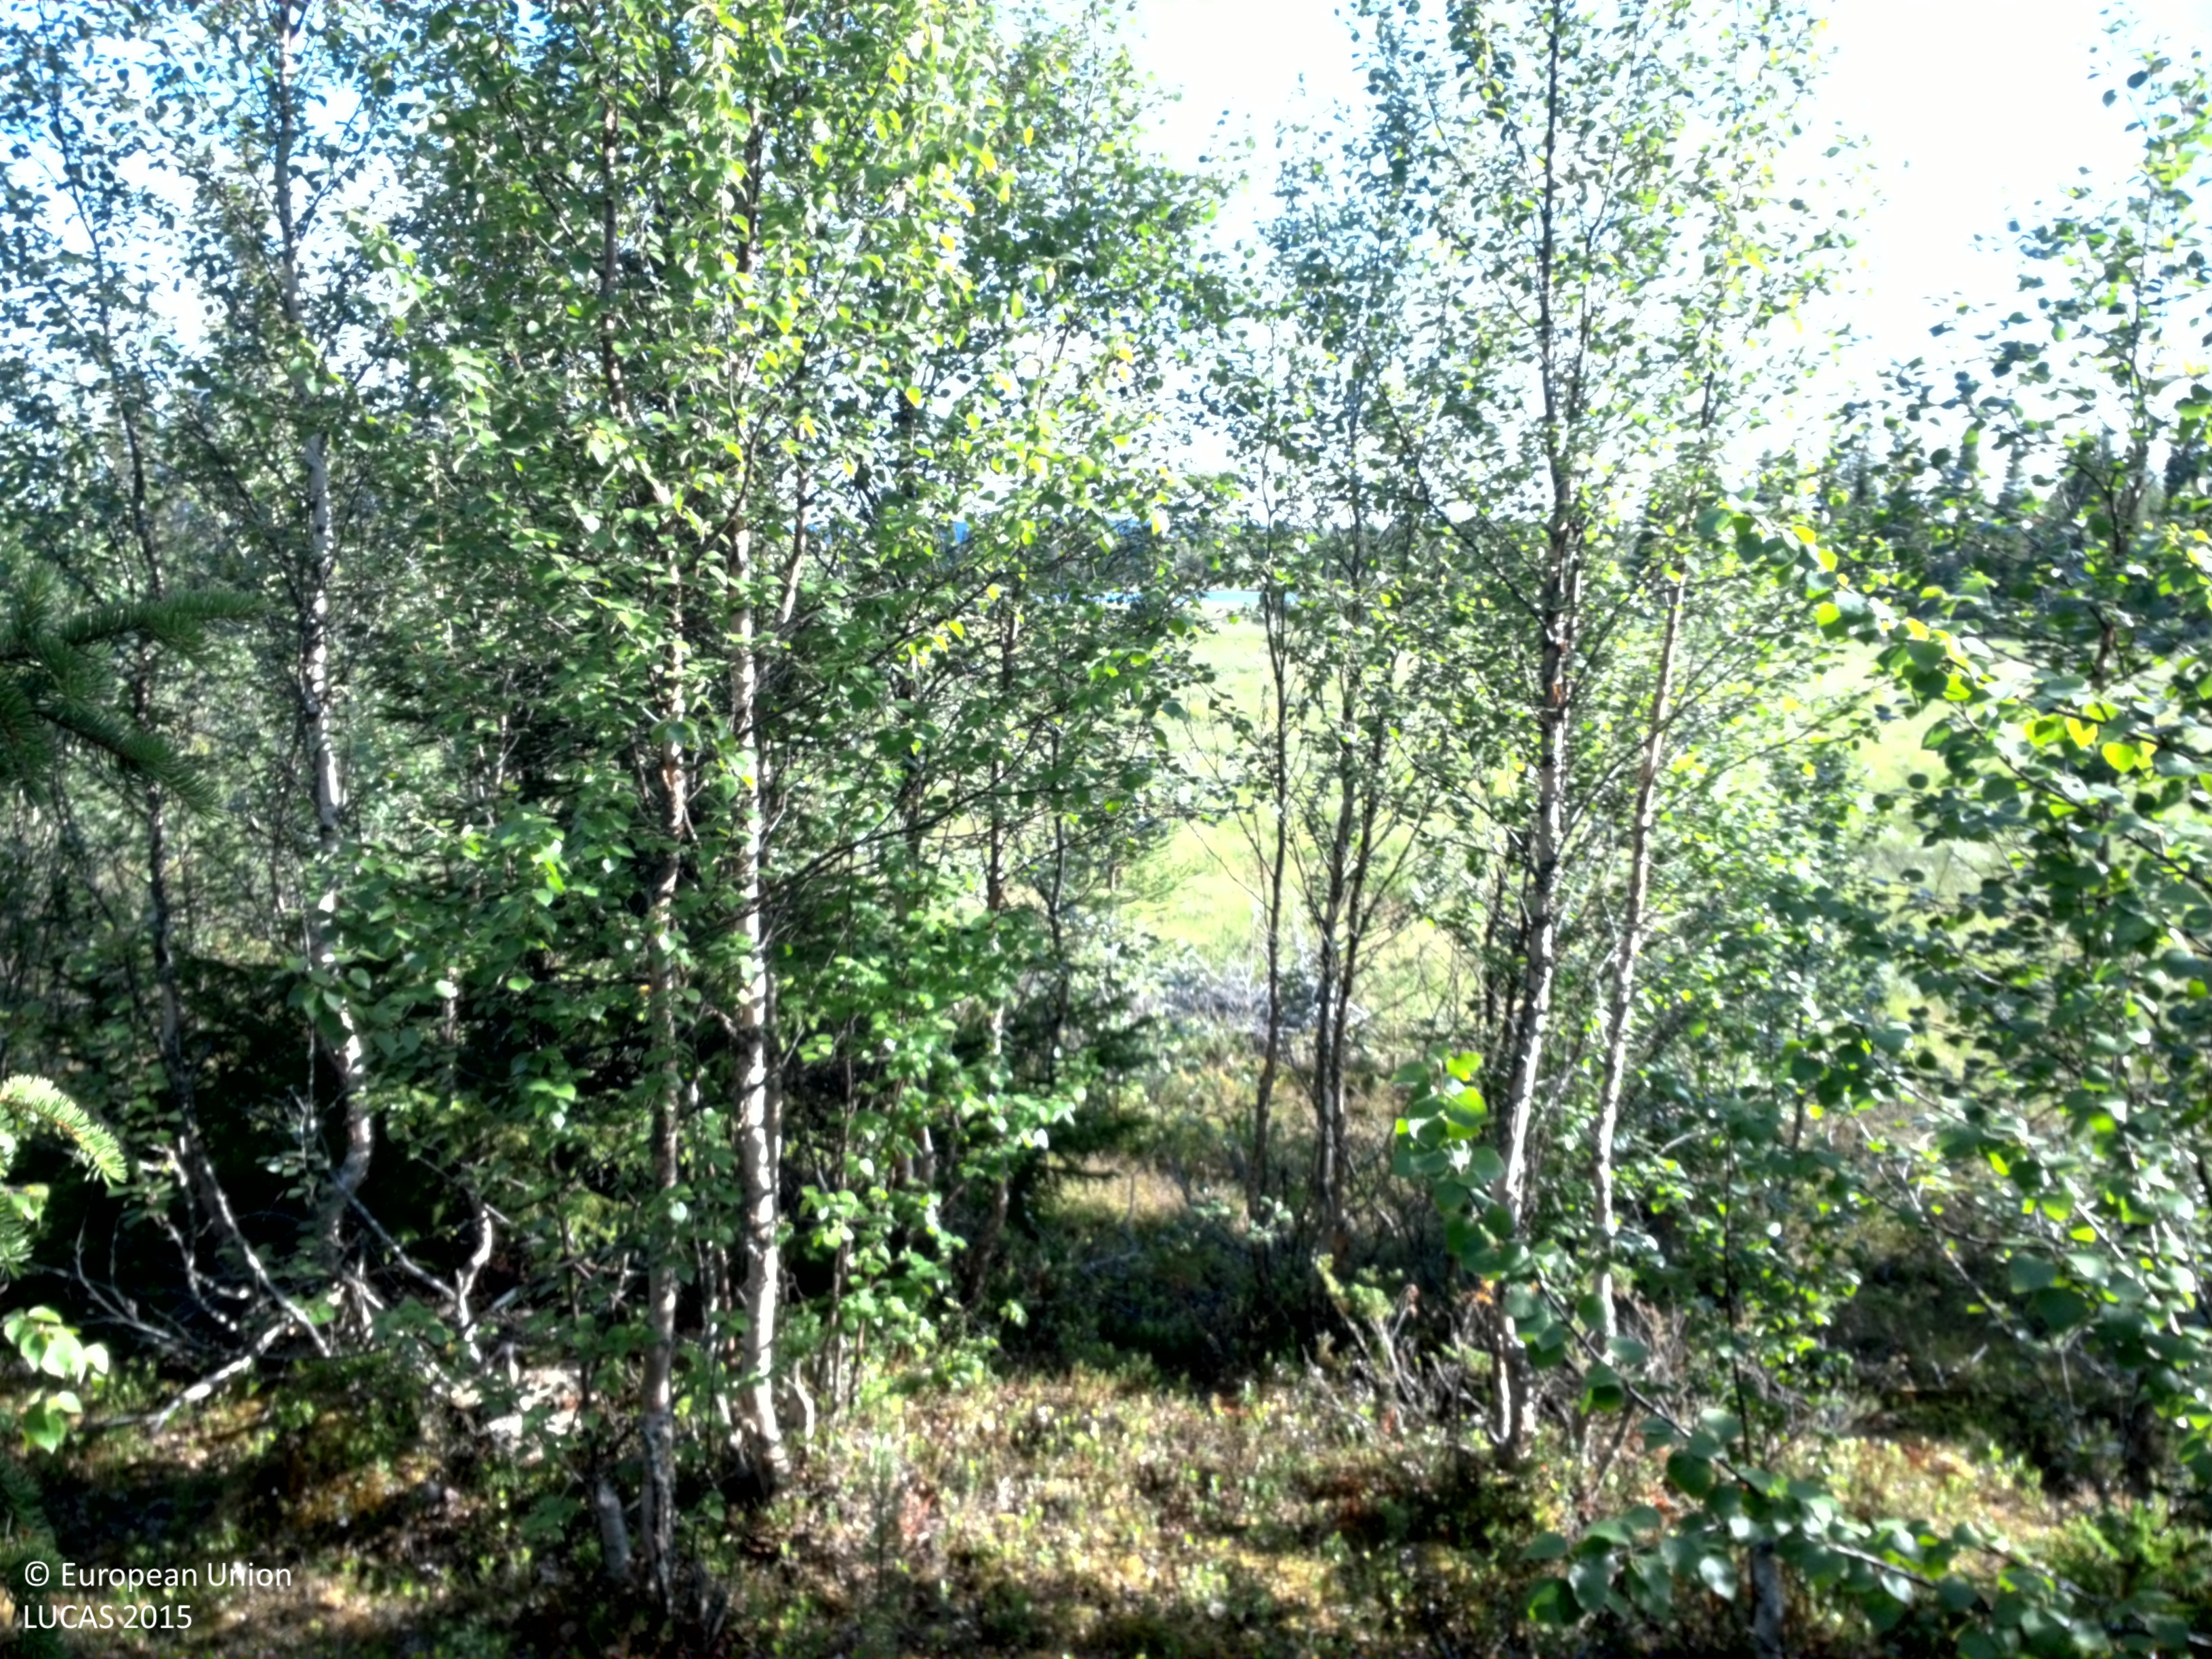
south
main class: Woodland
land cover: Spruce dominated mixed woodland
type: boreal forest
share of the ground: 25 - 50 %
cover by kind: shrubs 50 %, broadleaved forest trees 30 %, coniferous forest trees 10 %, lichens and mosses 10 %
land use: Forestry
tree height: > 5 m
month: August
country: SE
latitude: 65.0926
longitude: 16.1999
